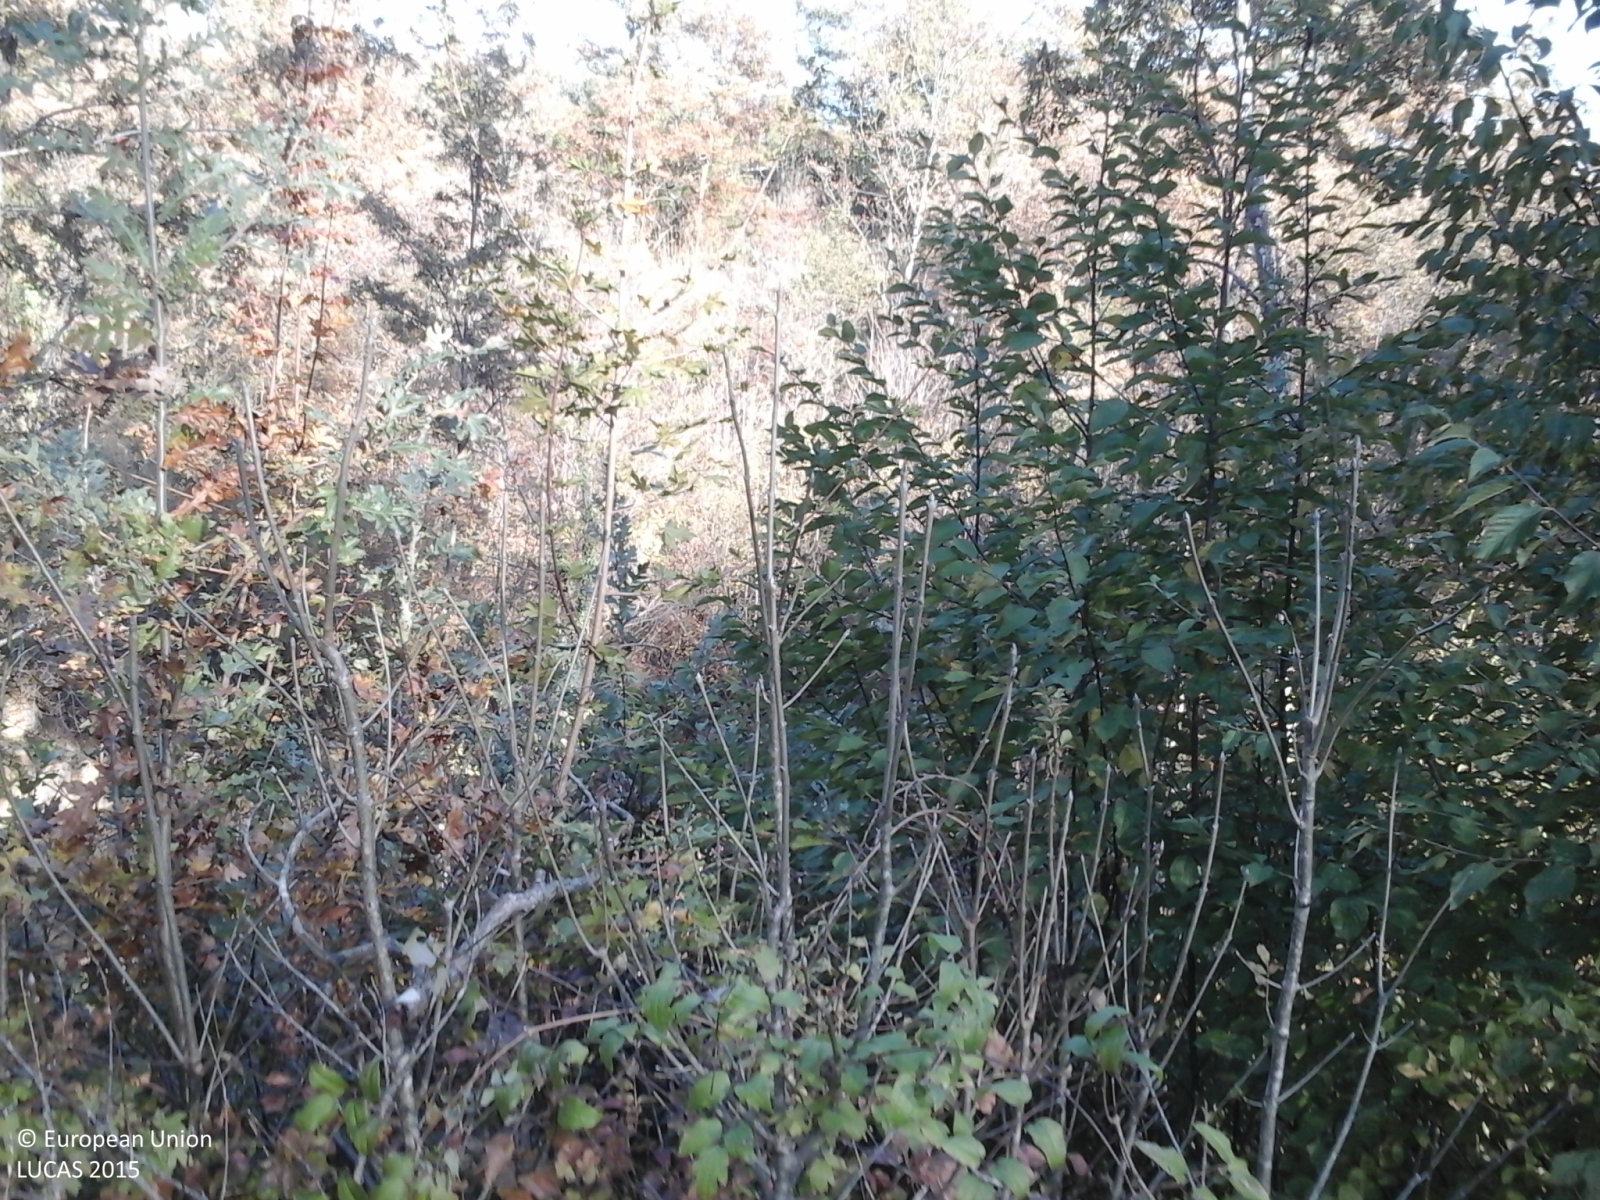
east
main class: Woodland
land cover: Broadleaved woodland
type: mesophytic deciduous forest
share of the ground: > 75 %
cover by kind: broadleaved forest trees 100 %
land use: Forestry
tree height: > 5 m
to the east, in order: Broadleaved woodland; Olive groves; Broadleaved woodland; Grassland with sparse tree/shrub cover; Olive groves; Grassland with sparse tree/shrub cover
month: August
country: IT
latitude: 43.1360
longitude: 11.0663
